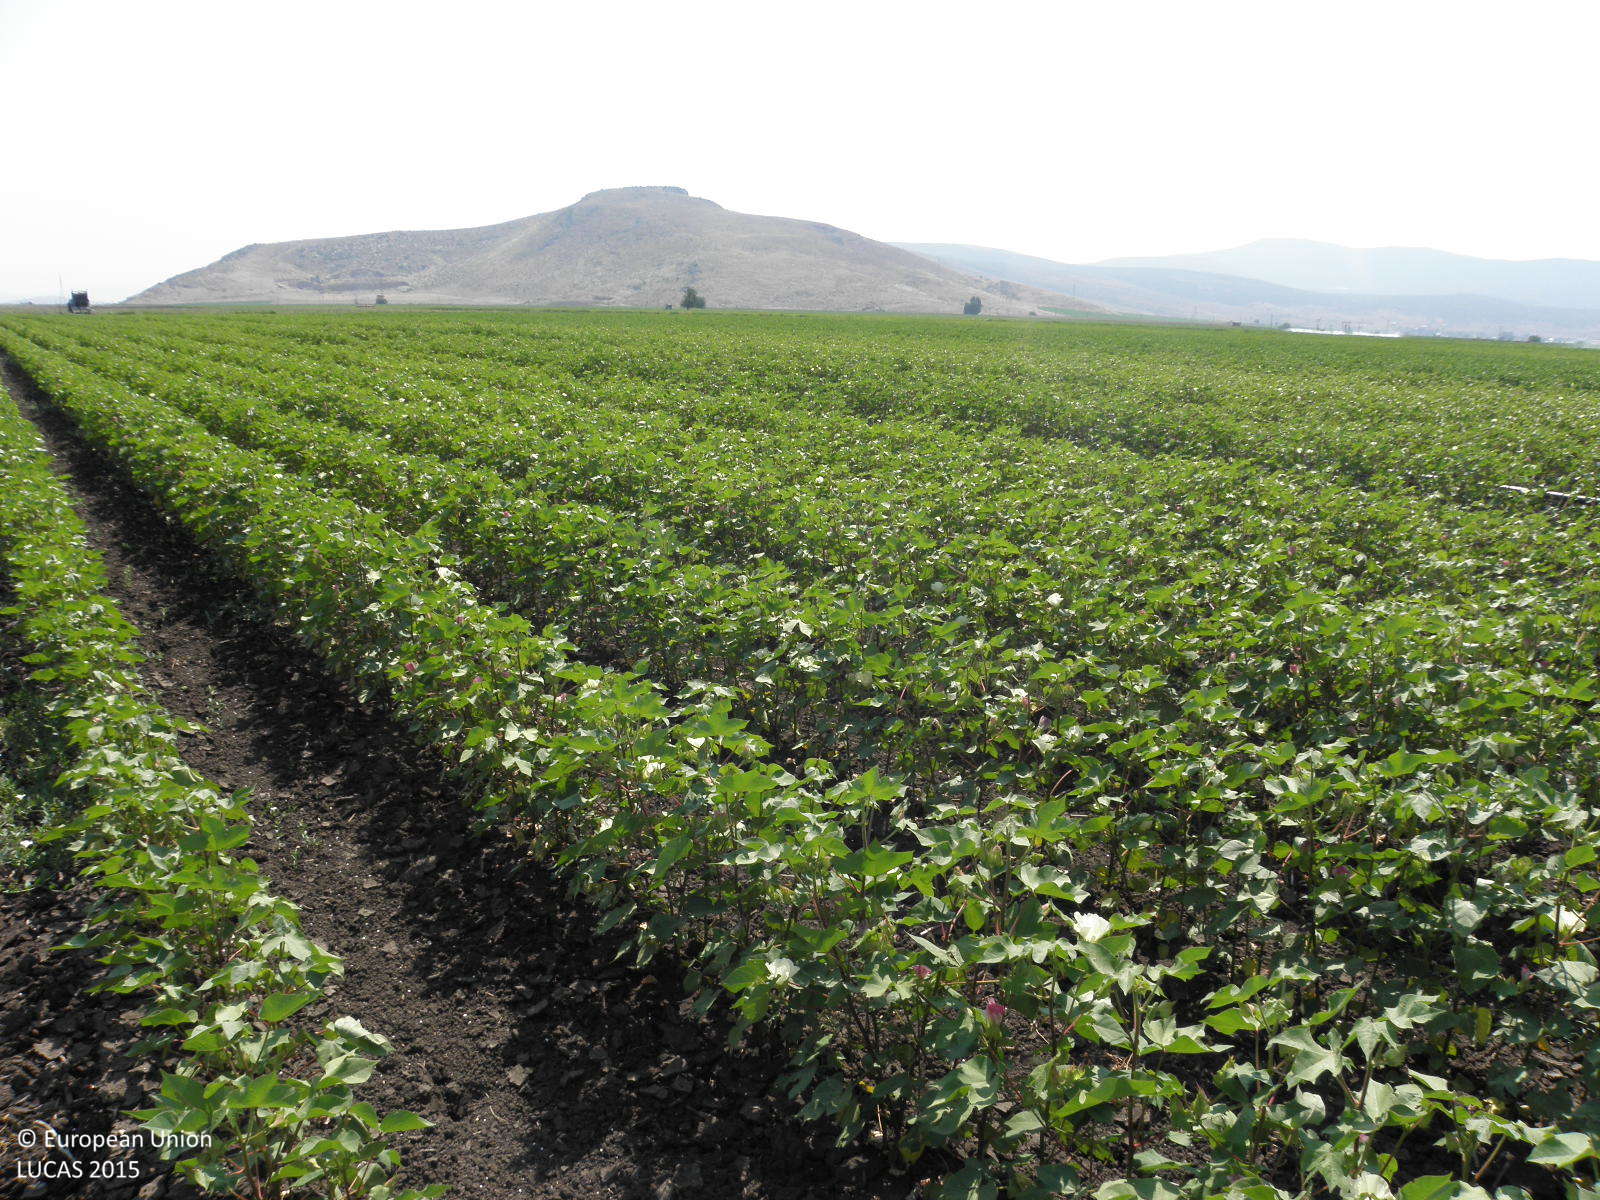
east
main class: Cropland
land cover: Cotton
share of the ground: > 75 %
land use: Agriculture (excluding fallow land and kitchen gardens)
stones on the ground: < 10 %
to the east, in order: Cotton; Grass margins; Ditches and canals; Grass margins; Barley
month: July
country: GR
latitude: 39.2909
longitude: 22.2859
